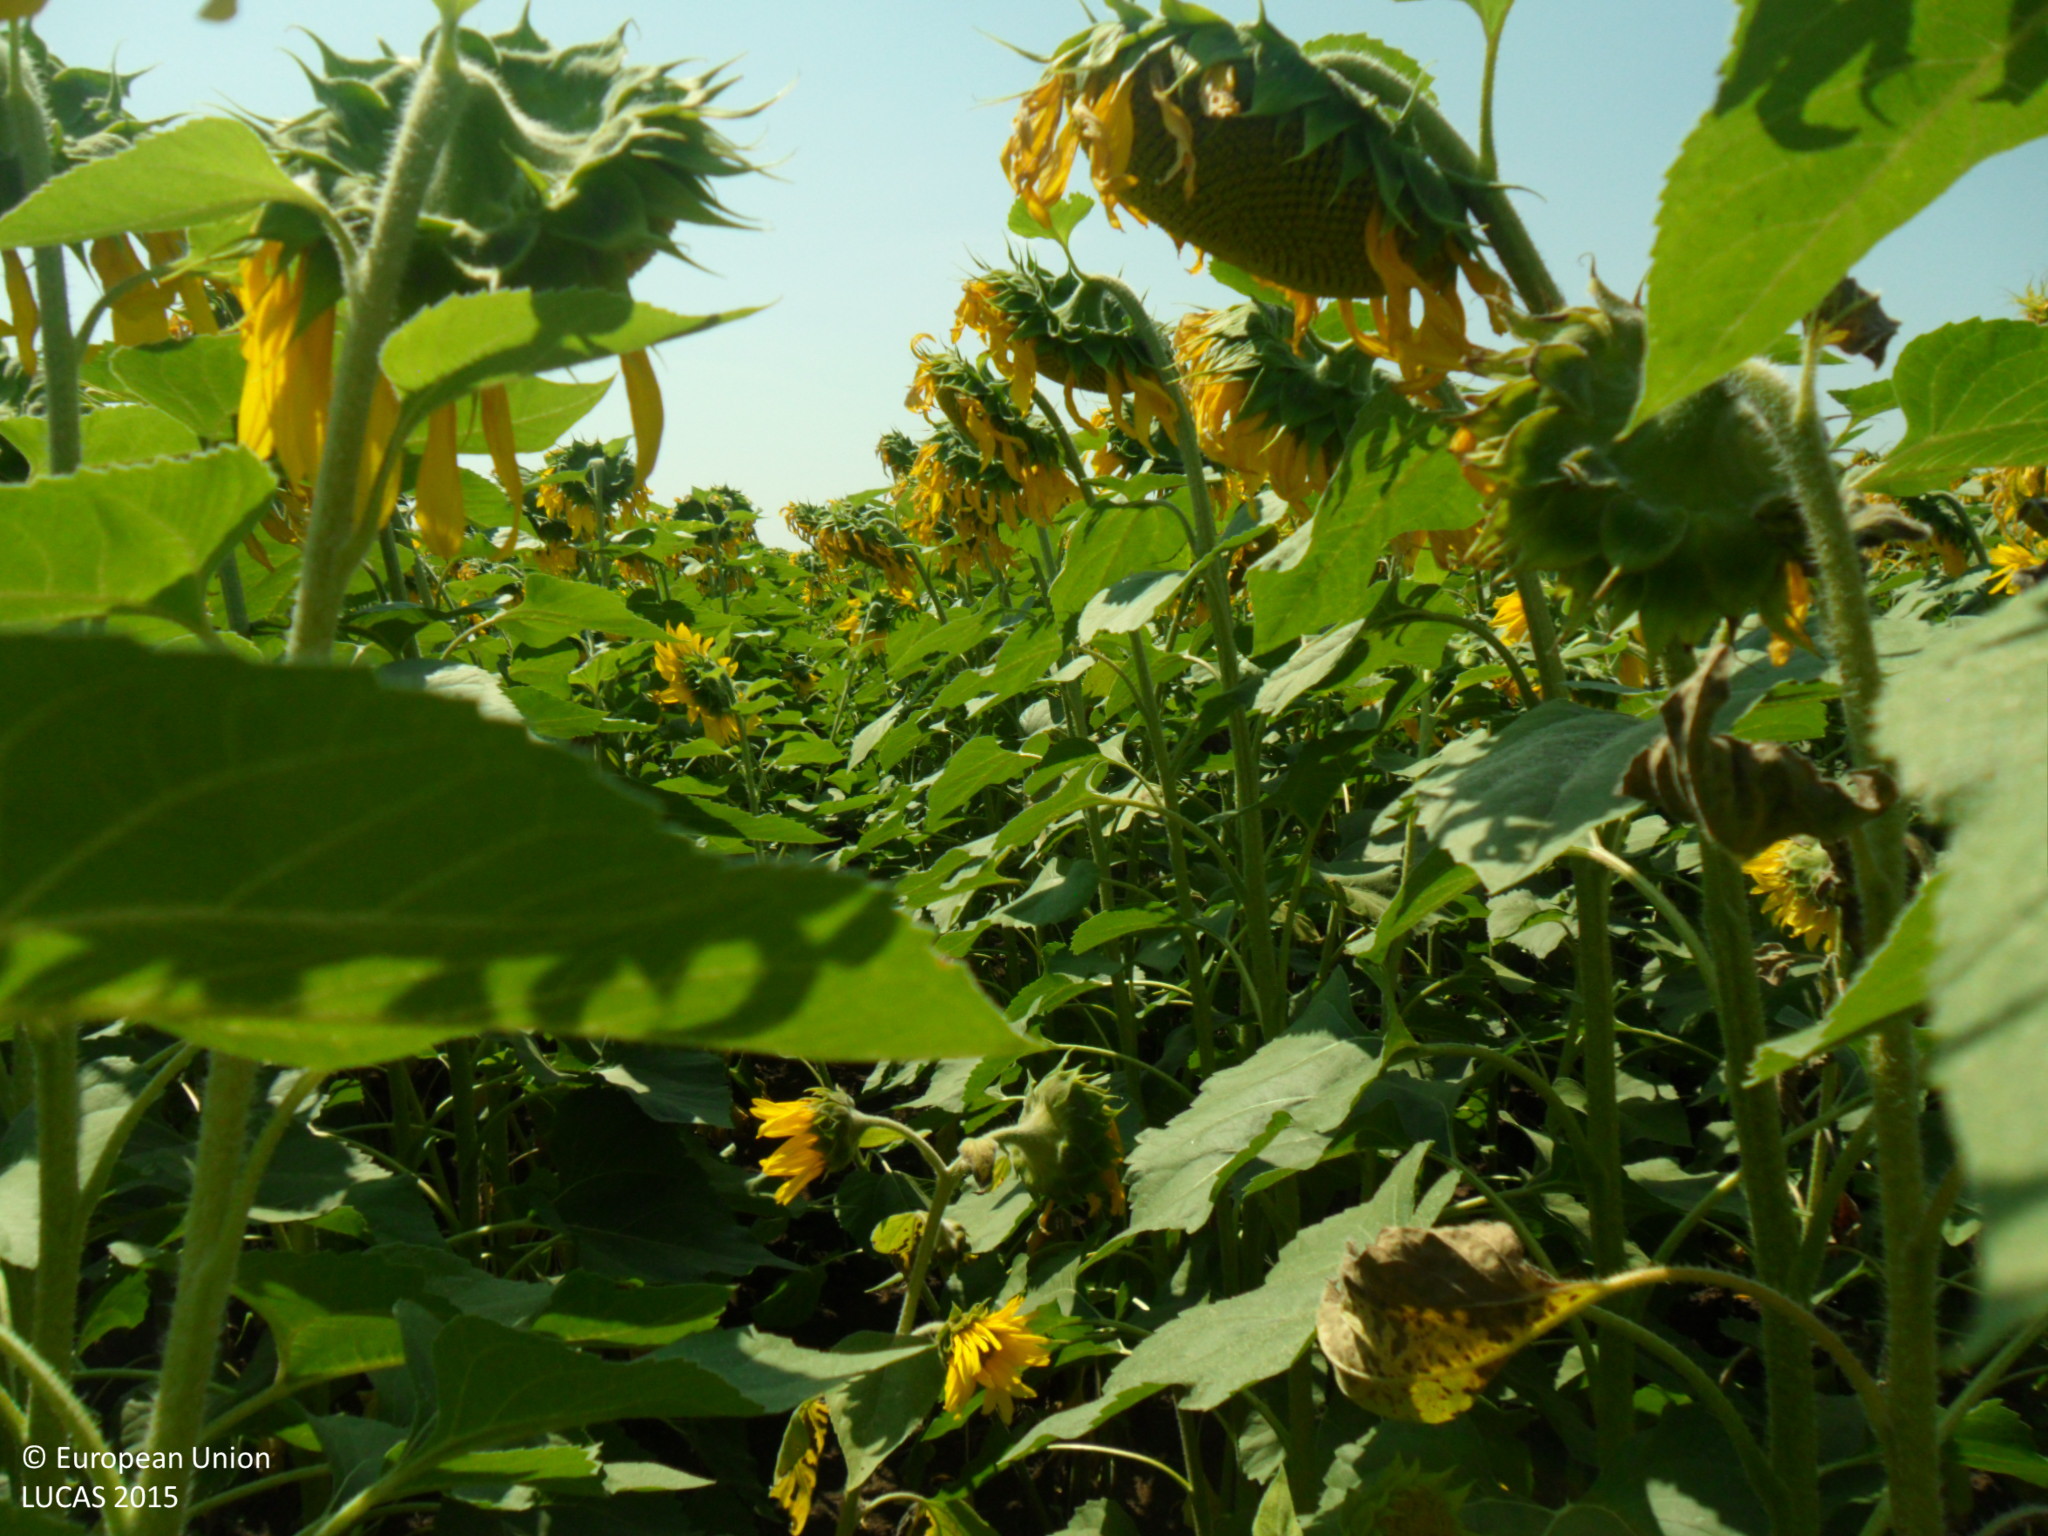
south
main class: Cropland
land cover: Sunflower
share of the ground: > 75 %
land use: Agriculture (excluding fallow land and kitchen gardens)
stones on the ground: < 10 %
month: July
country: BG
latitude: 43.8648
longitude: 26.4957
